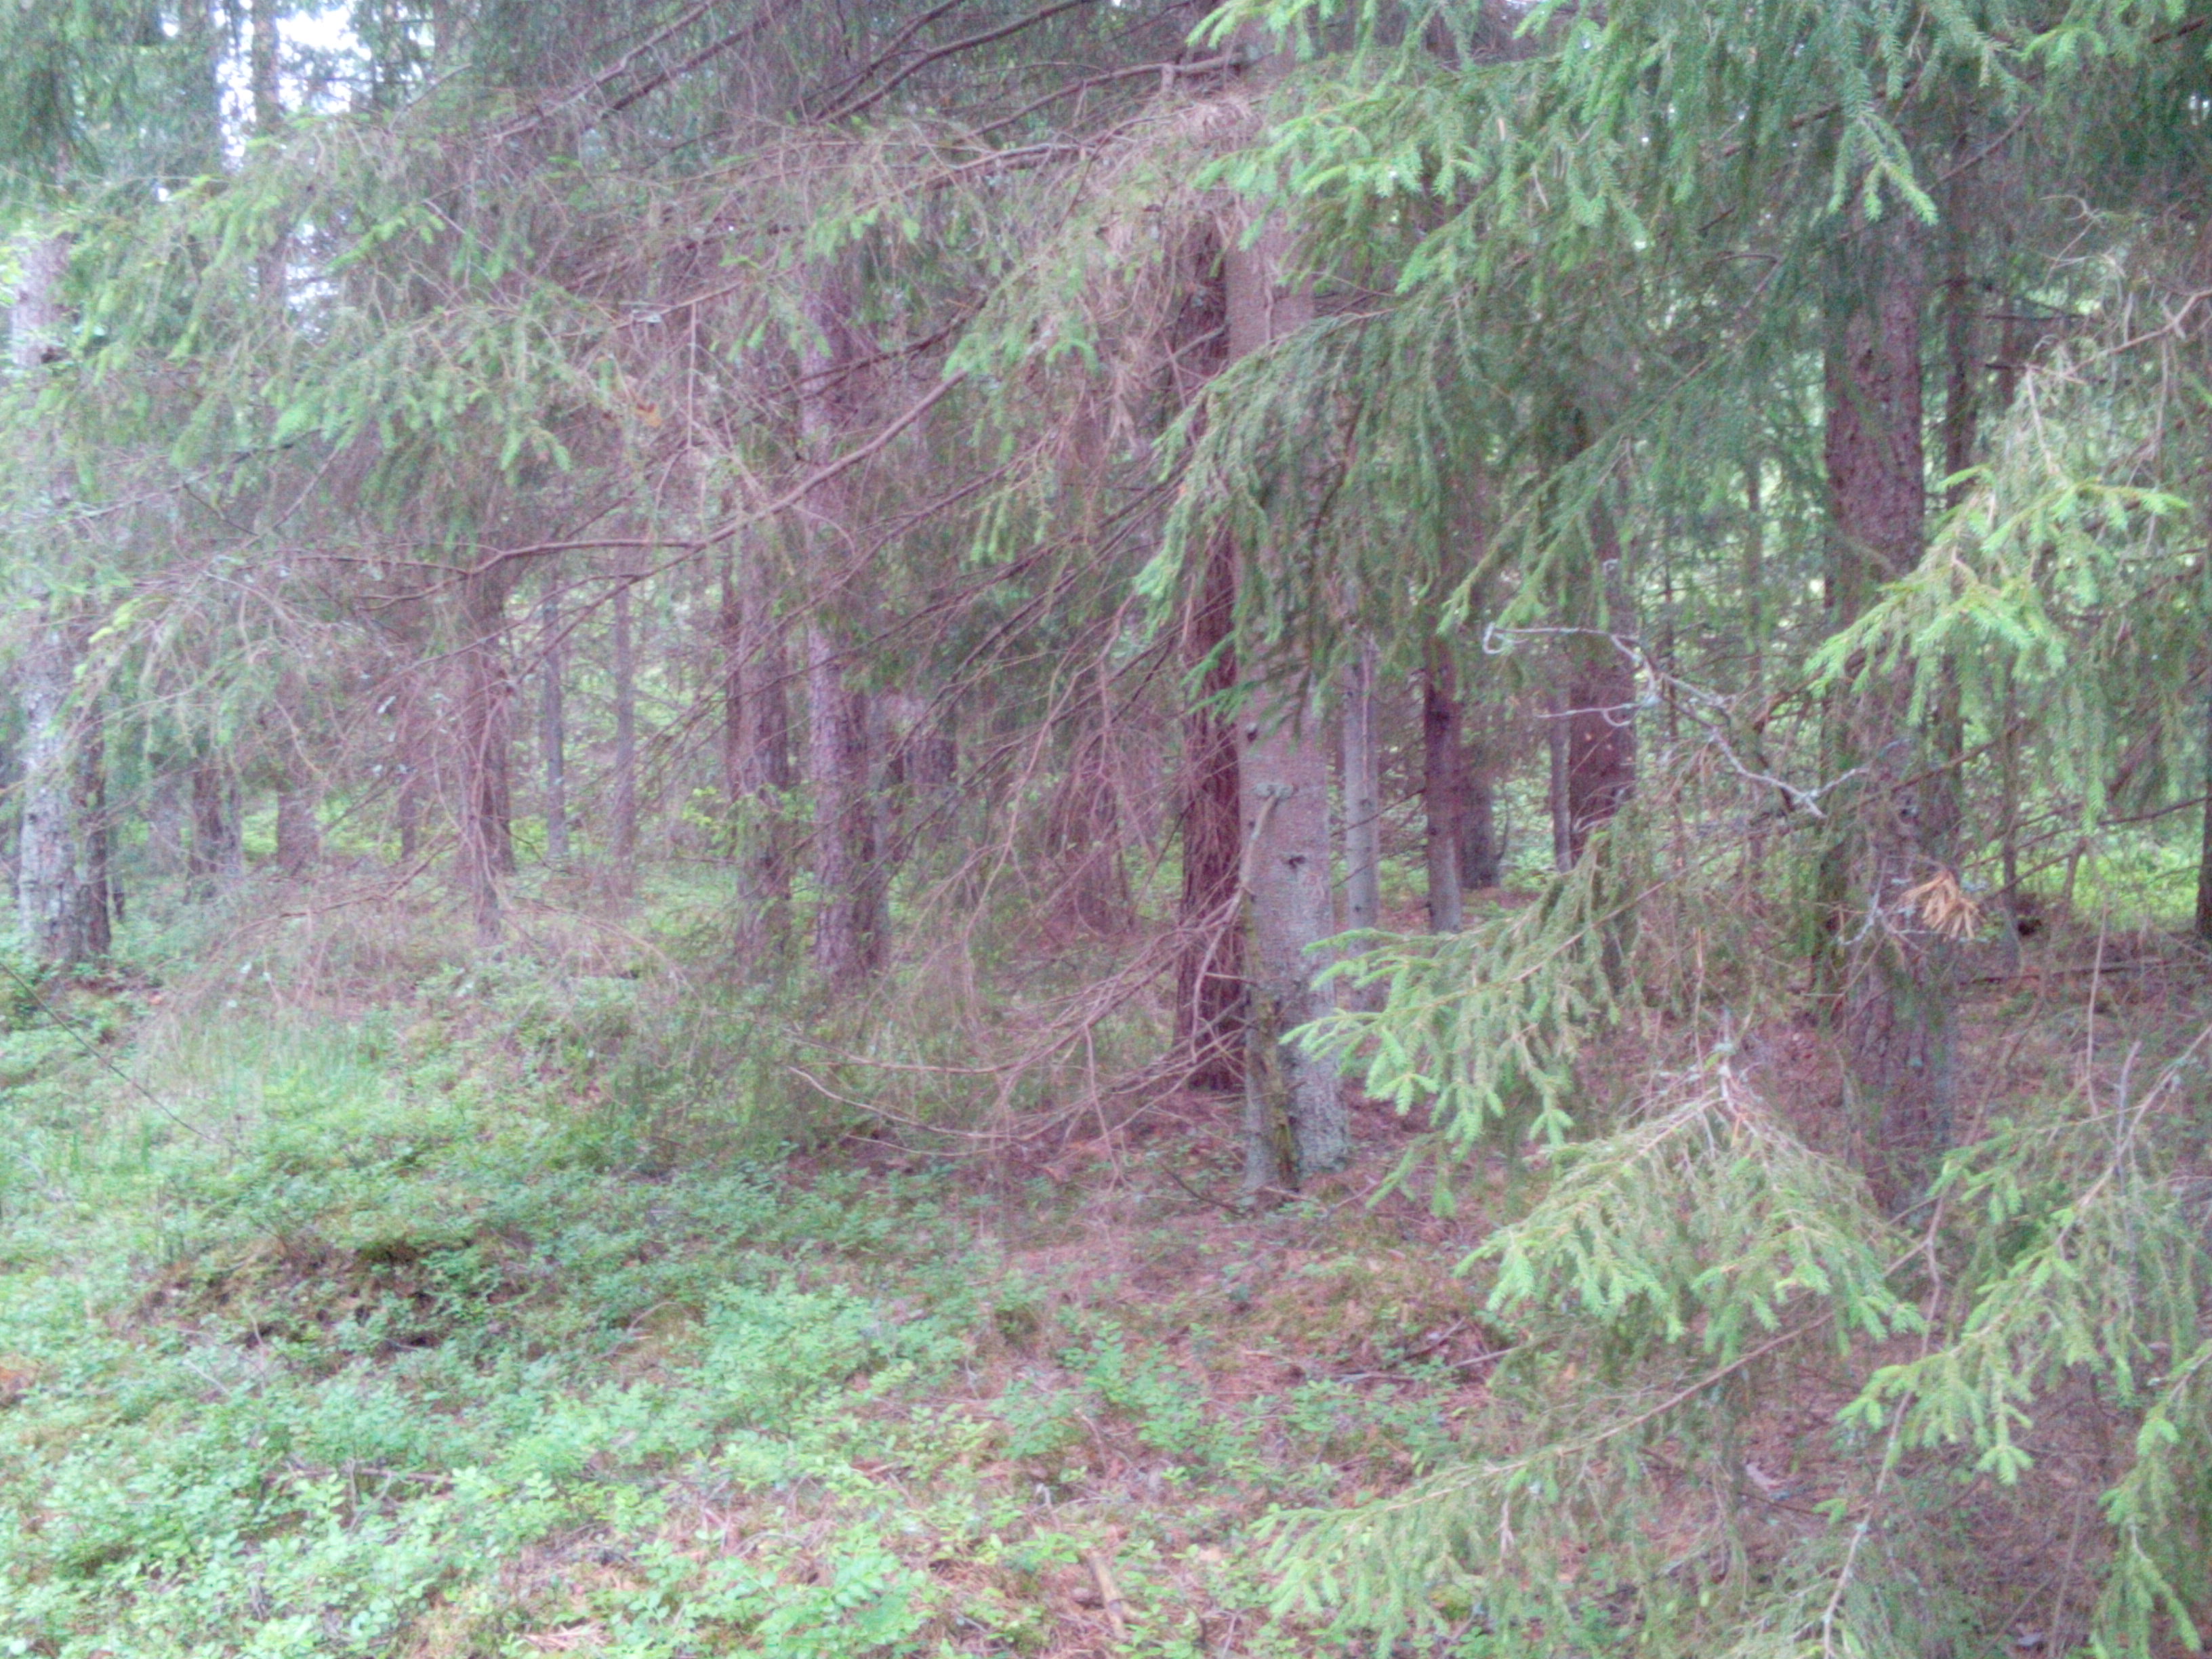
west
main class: Woodland
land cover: Other coniferous woodland
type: hemiboreal forest and nemoral coniferous forest and mixed broadleaved-coniferous forest
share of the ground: > 75 %
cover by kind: coniferous forest trees 80 %, herbaceous plants 10 %, lichens and mosses 10 %
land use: Forestry
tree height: > 5 m
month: June
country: LV
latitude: 56.9420
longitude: 21.4971
